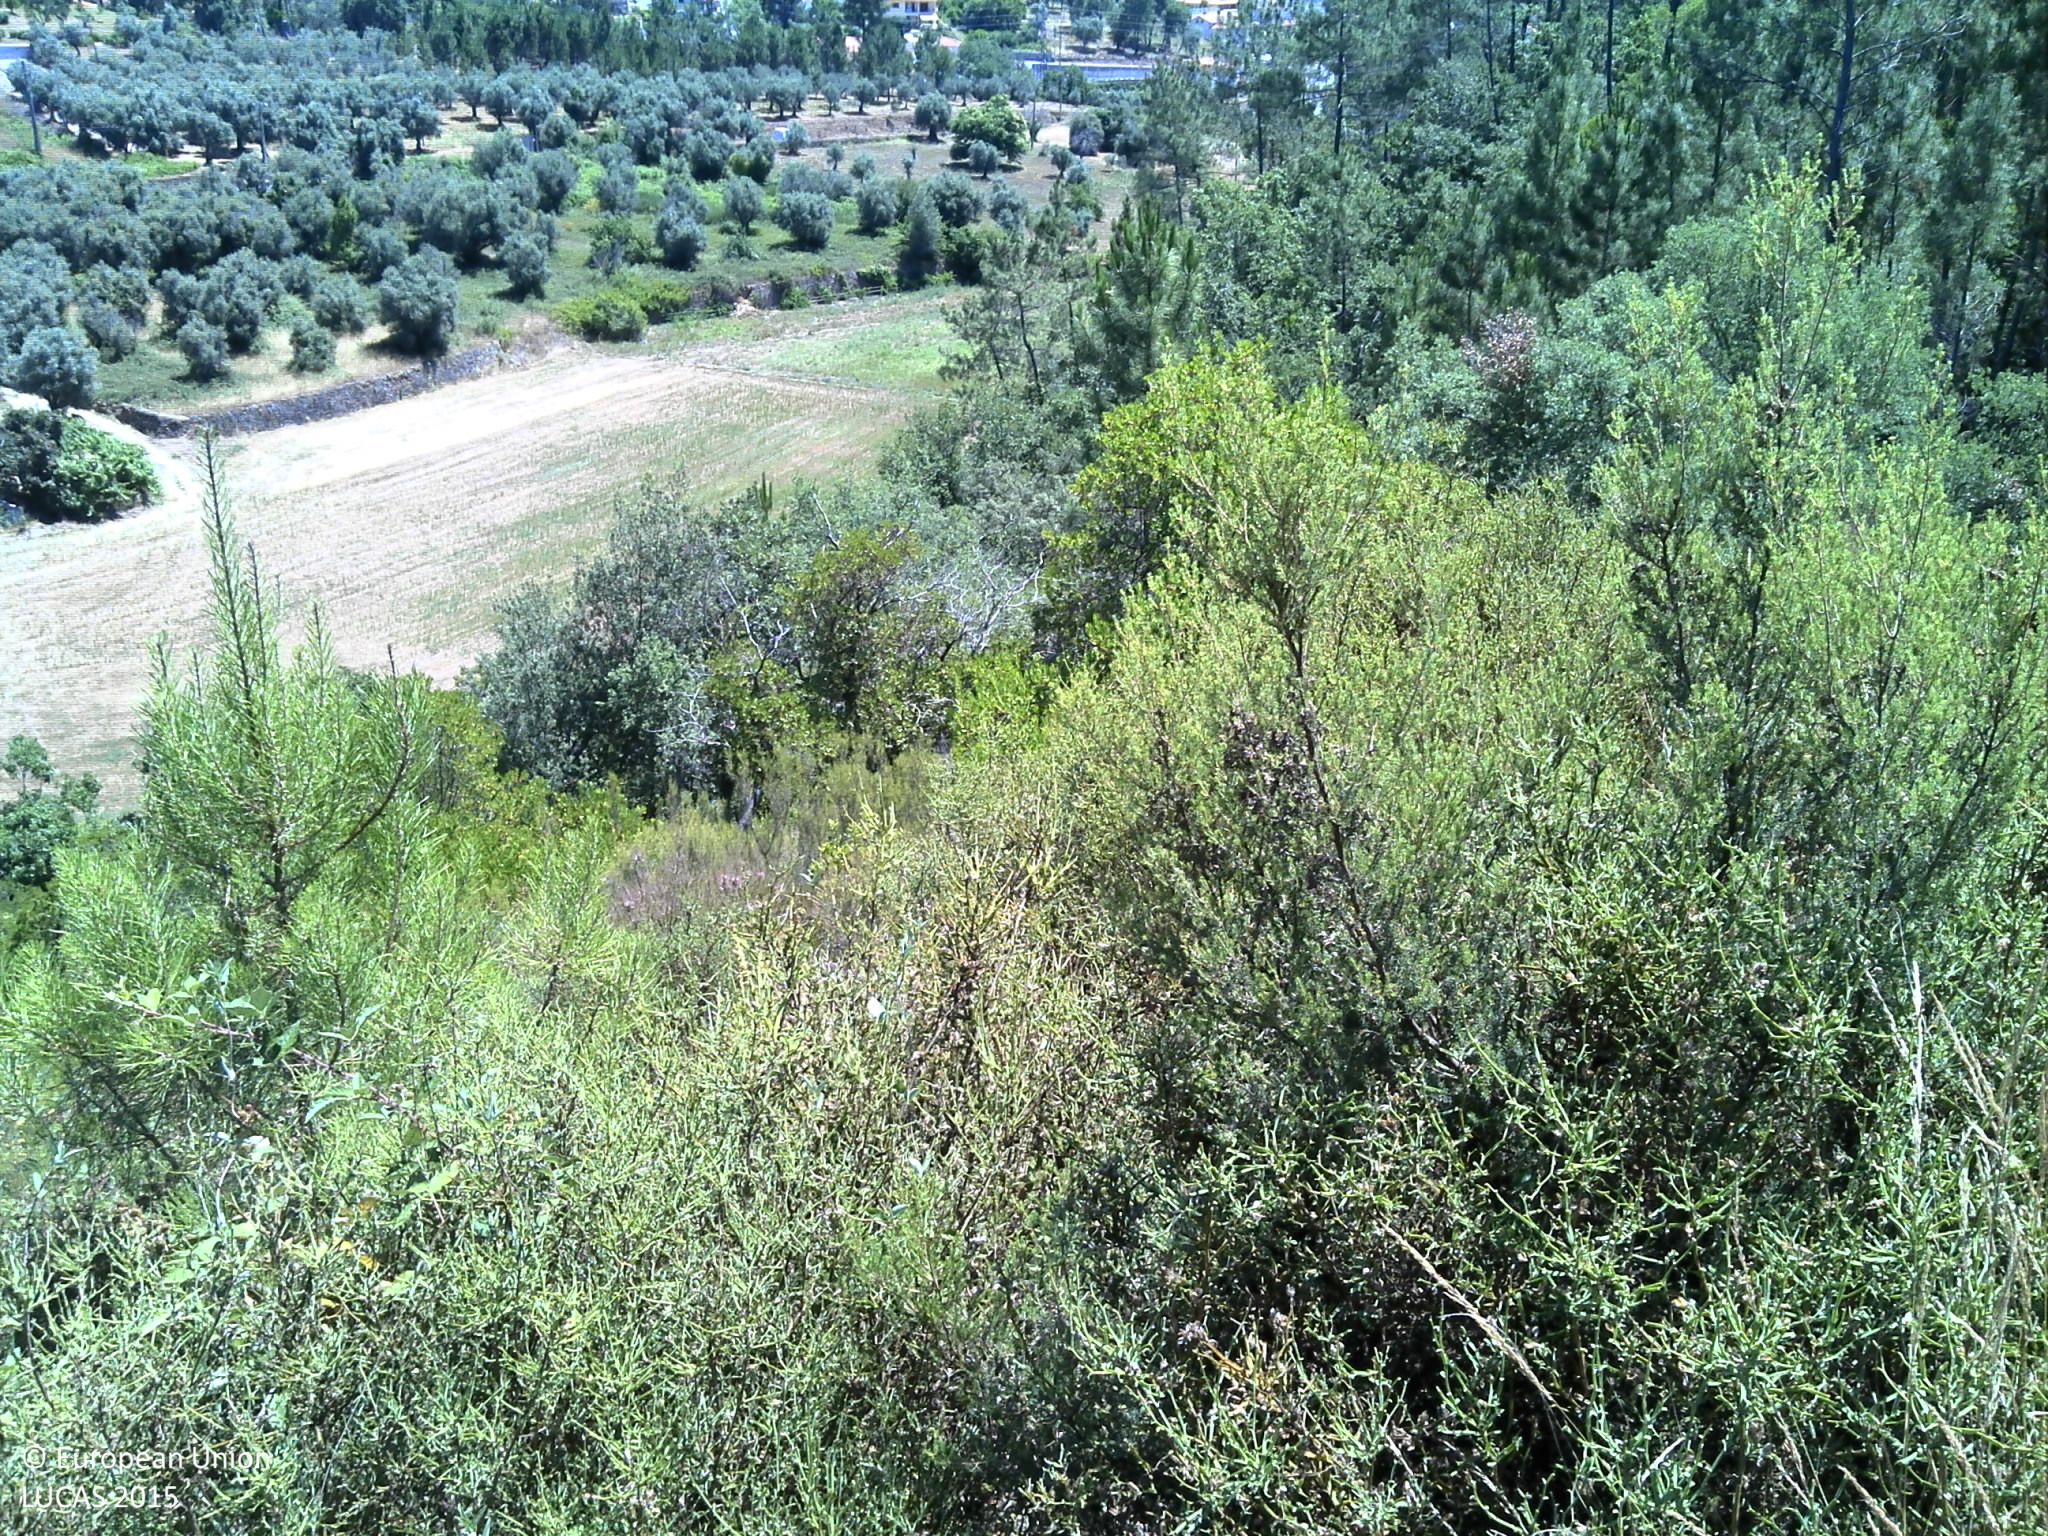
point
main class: Shrubland
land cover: Shrubland with sparse tree cover
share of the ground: > 75 %
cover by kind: shrubs 75 %, unconsolidated bare surface 15 %, coniferous forest trees 5 %, herbaceous plants 5 %
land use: Forestry
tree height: > 5 m
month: July
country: PT
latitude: 39.8039
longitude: -8.1132
